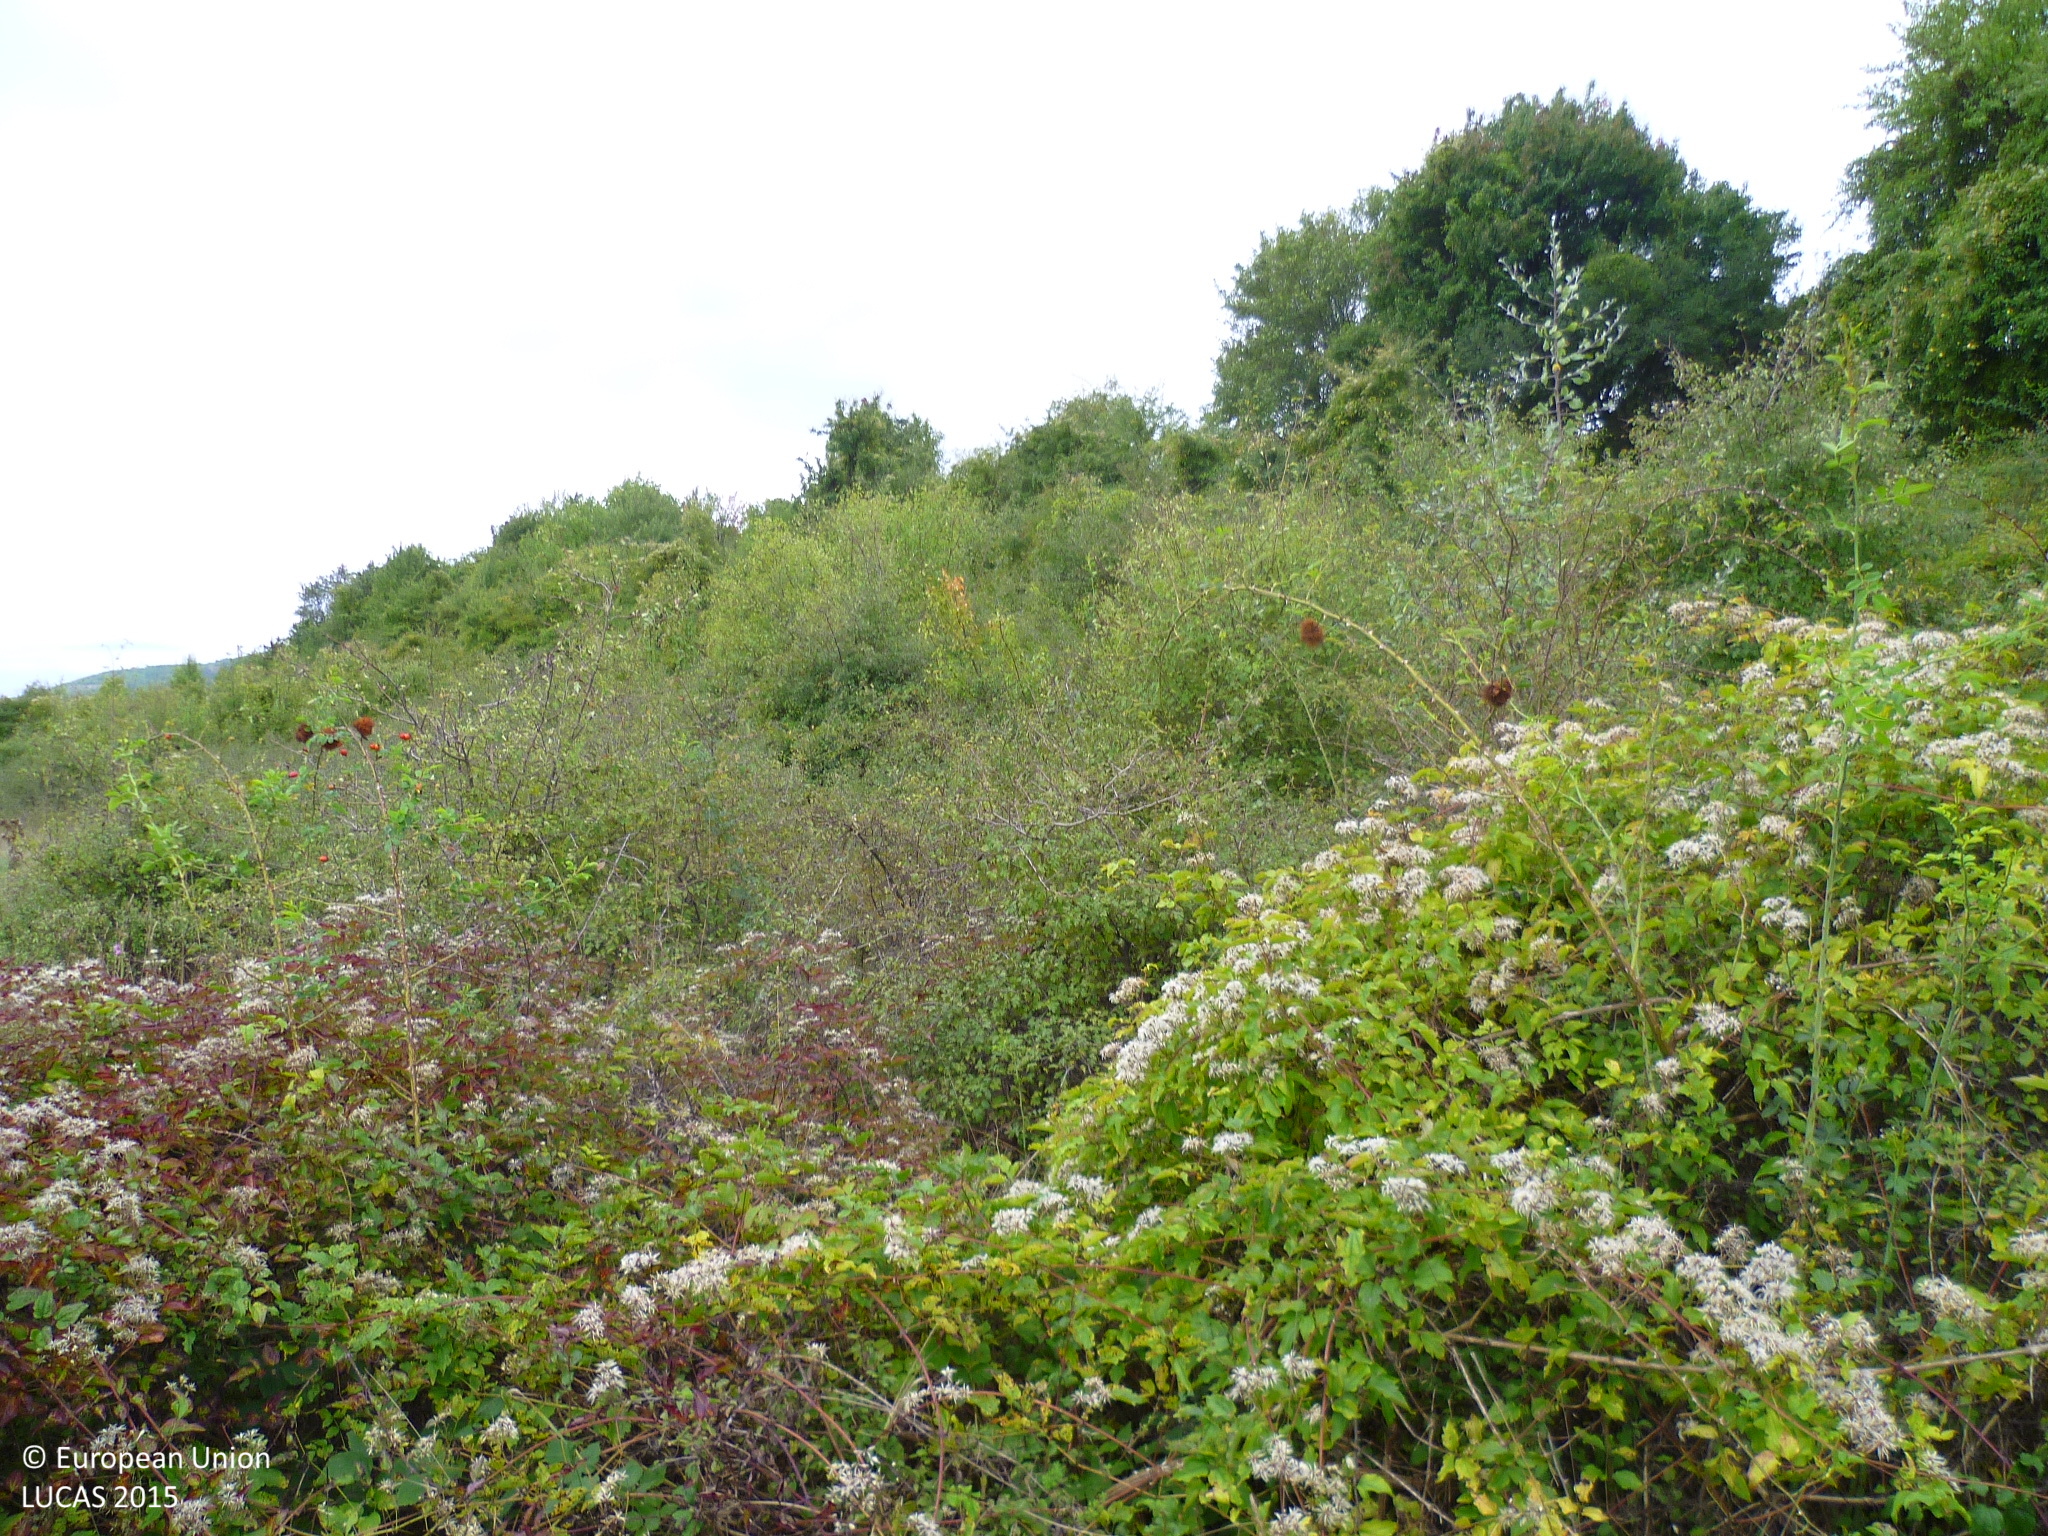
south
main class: Woodland
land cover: Broadleaved woodland
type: mesophytic deciduous forest
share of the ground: > 75 %
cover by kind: broadleaved forest trees 80 %, herbaceous plants 15 %, shrubs 5 %
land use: Semi-natural and natural areas not in use
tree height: > 5 m
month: September
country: BG
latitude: 42.6336
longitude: 22.7199
